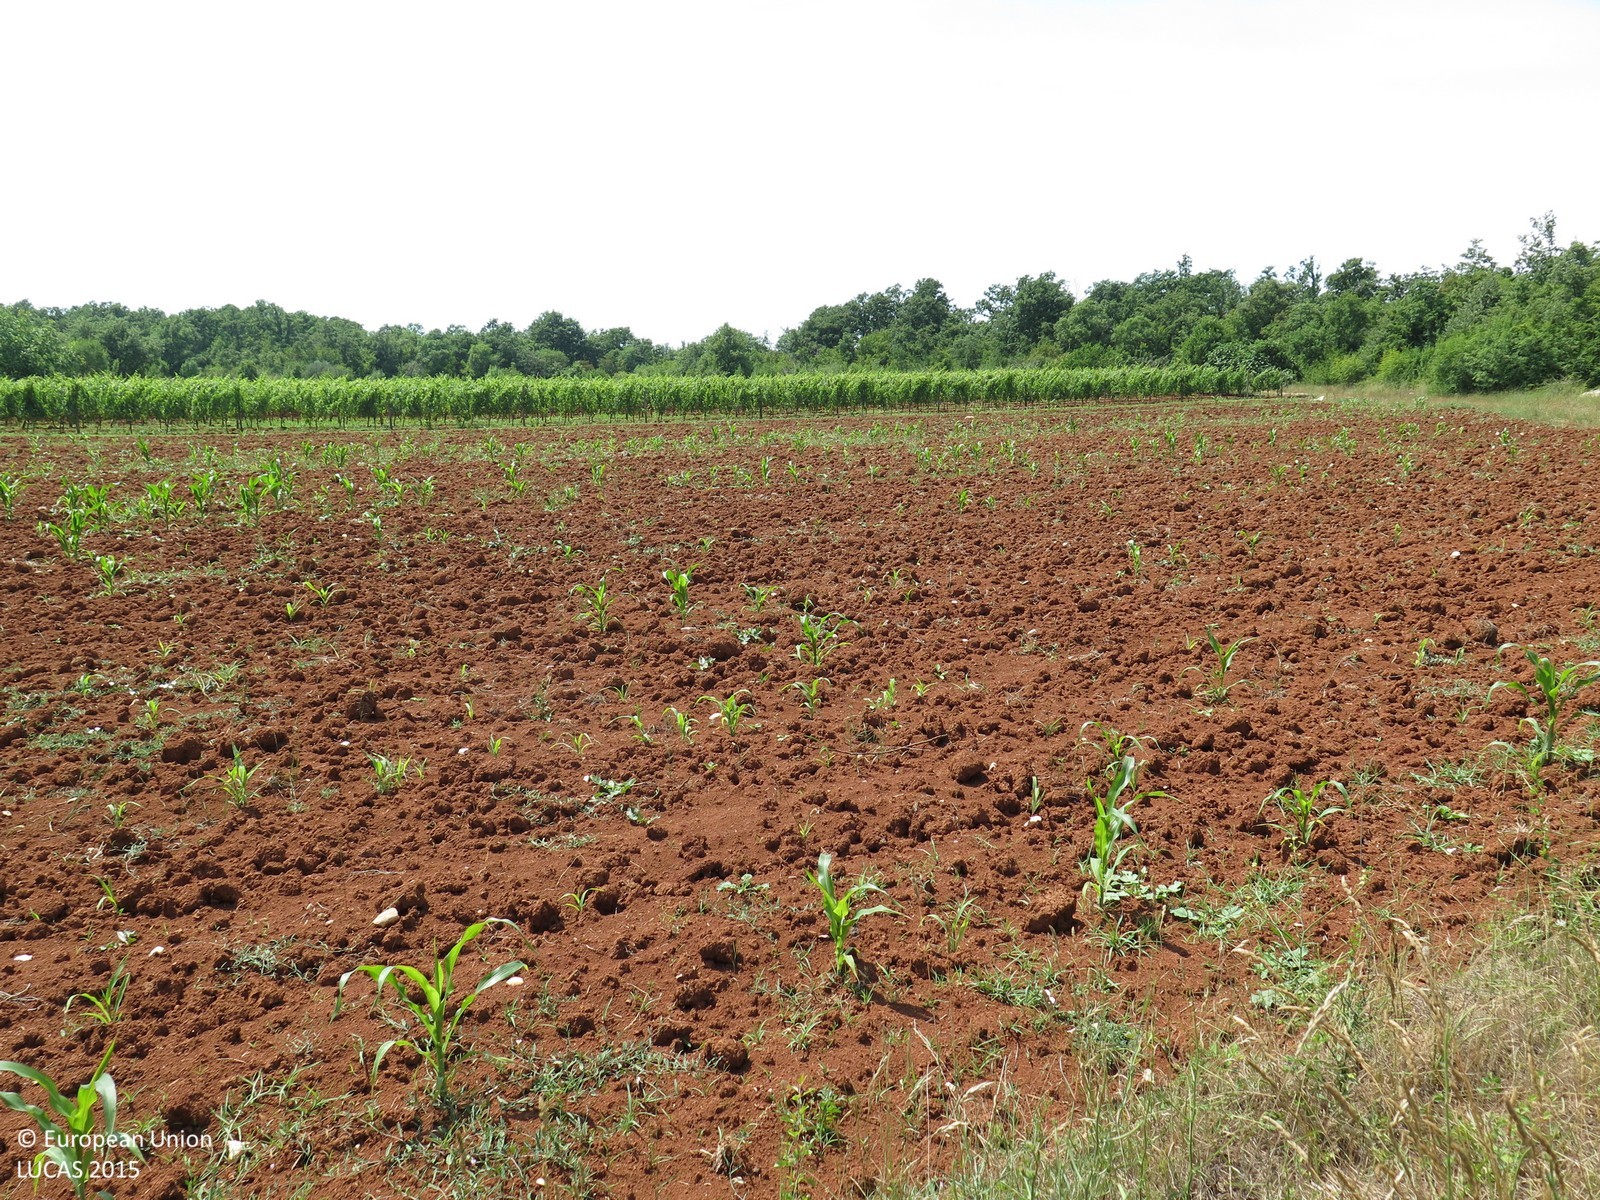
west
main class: Grassland
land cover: Grassland without tree/shrub cover
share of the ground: > 75 %
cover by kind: herbaceous plants 100 %
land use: Abandoned areas
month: June
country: HR
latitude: 45.1691
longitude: 13.6972
